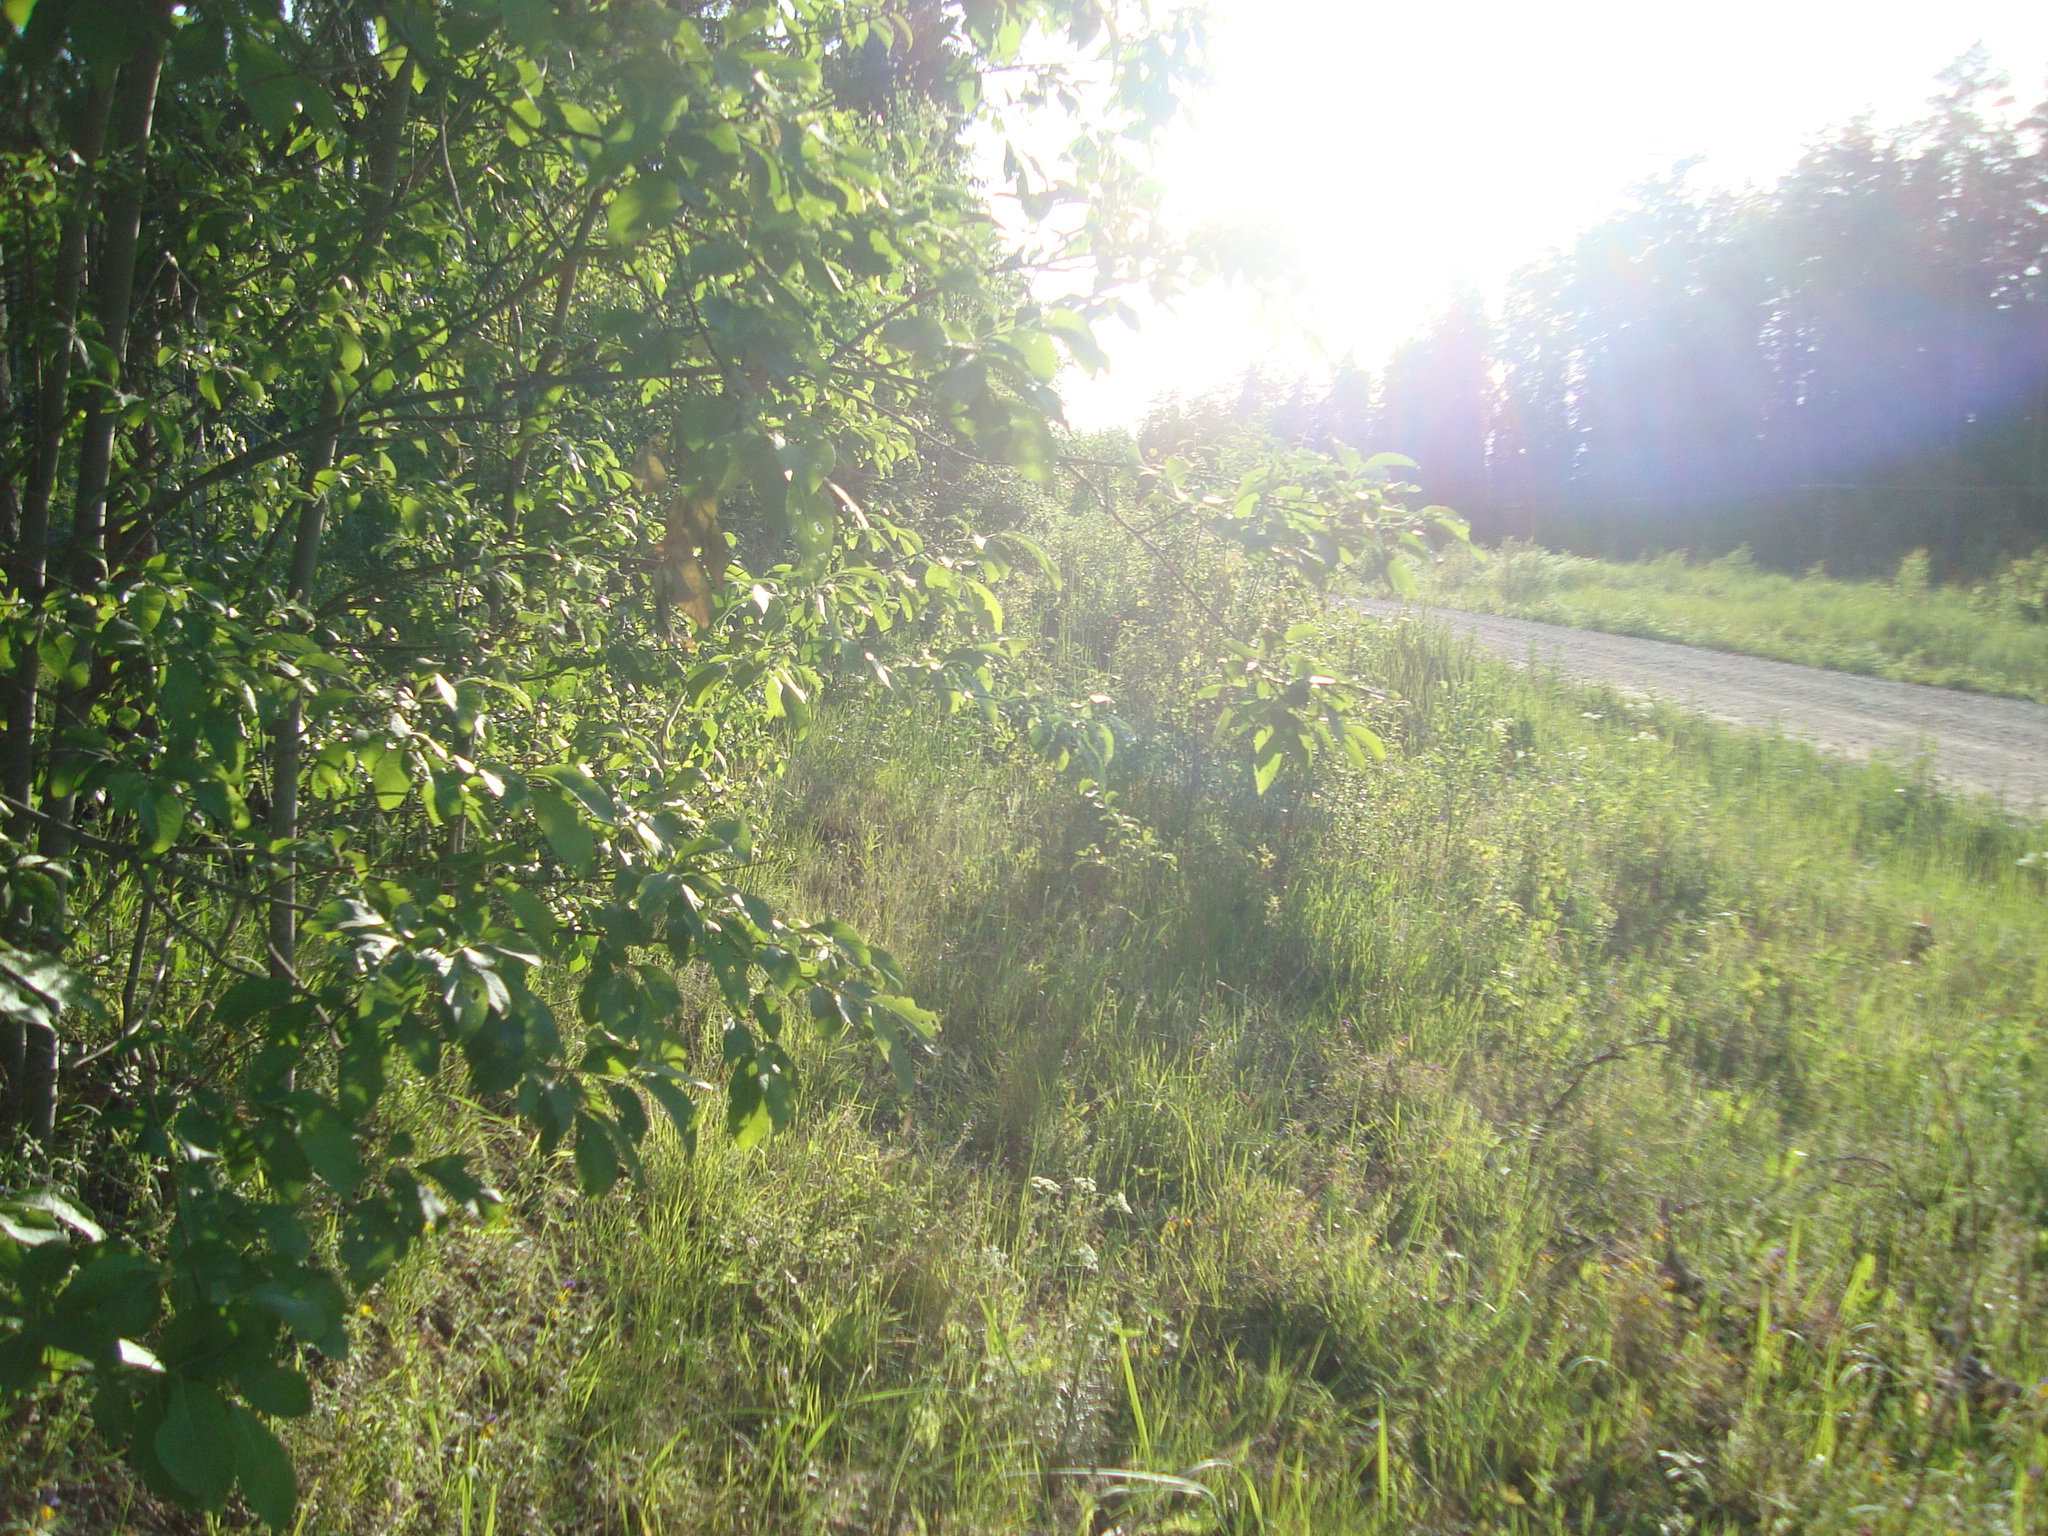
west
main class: Grassland
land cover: Grassland without tree/shrub cover
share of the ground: > 75 %
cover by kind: herbaceous plants 100 %
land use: Road transport
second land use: Forestry
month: June
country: LV
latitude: 56.8243
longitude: 26.1784
